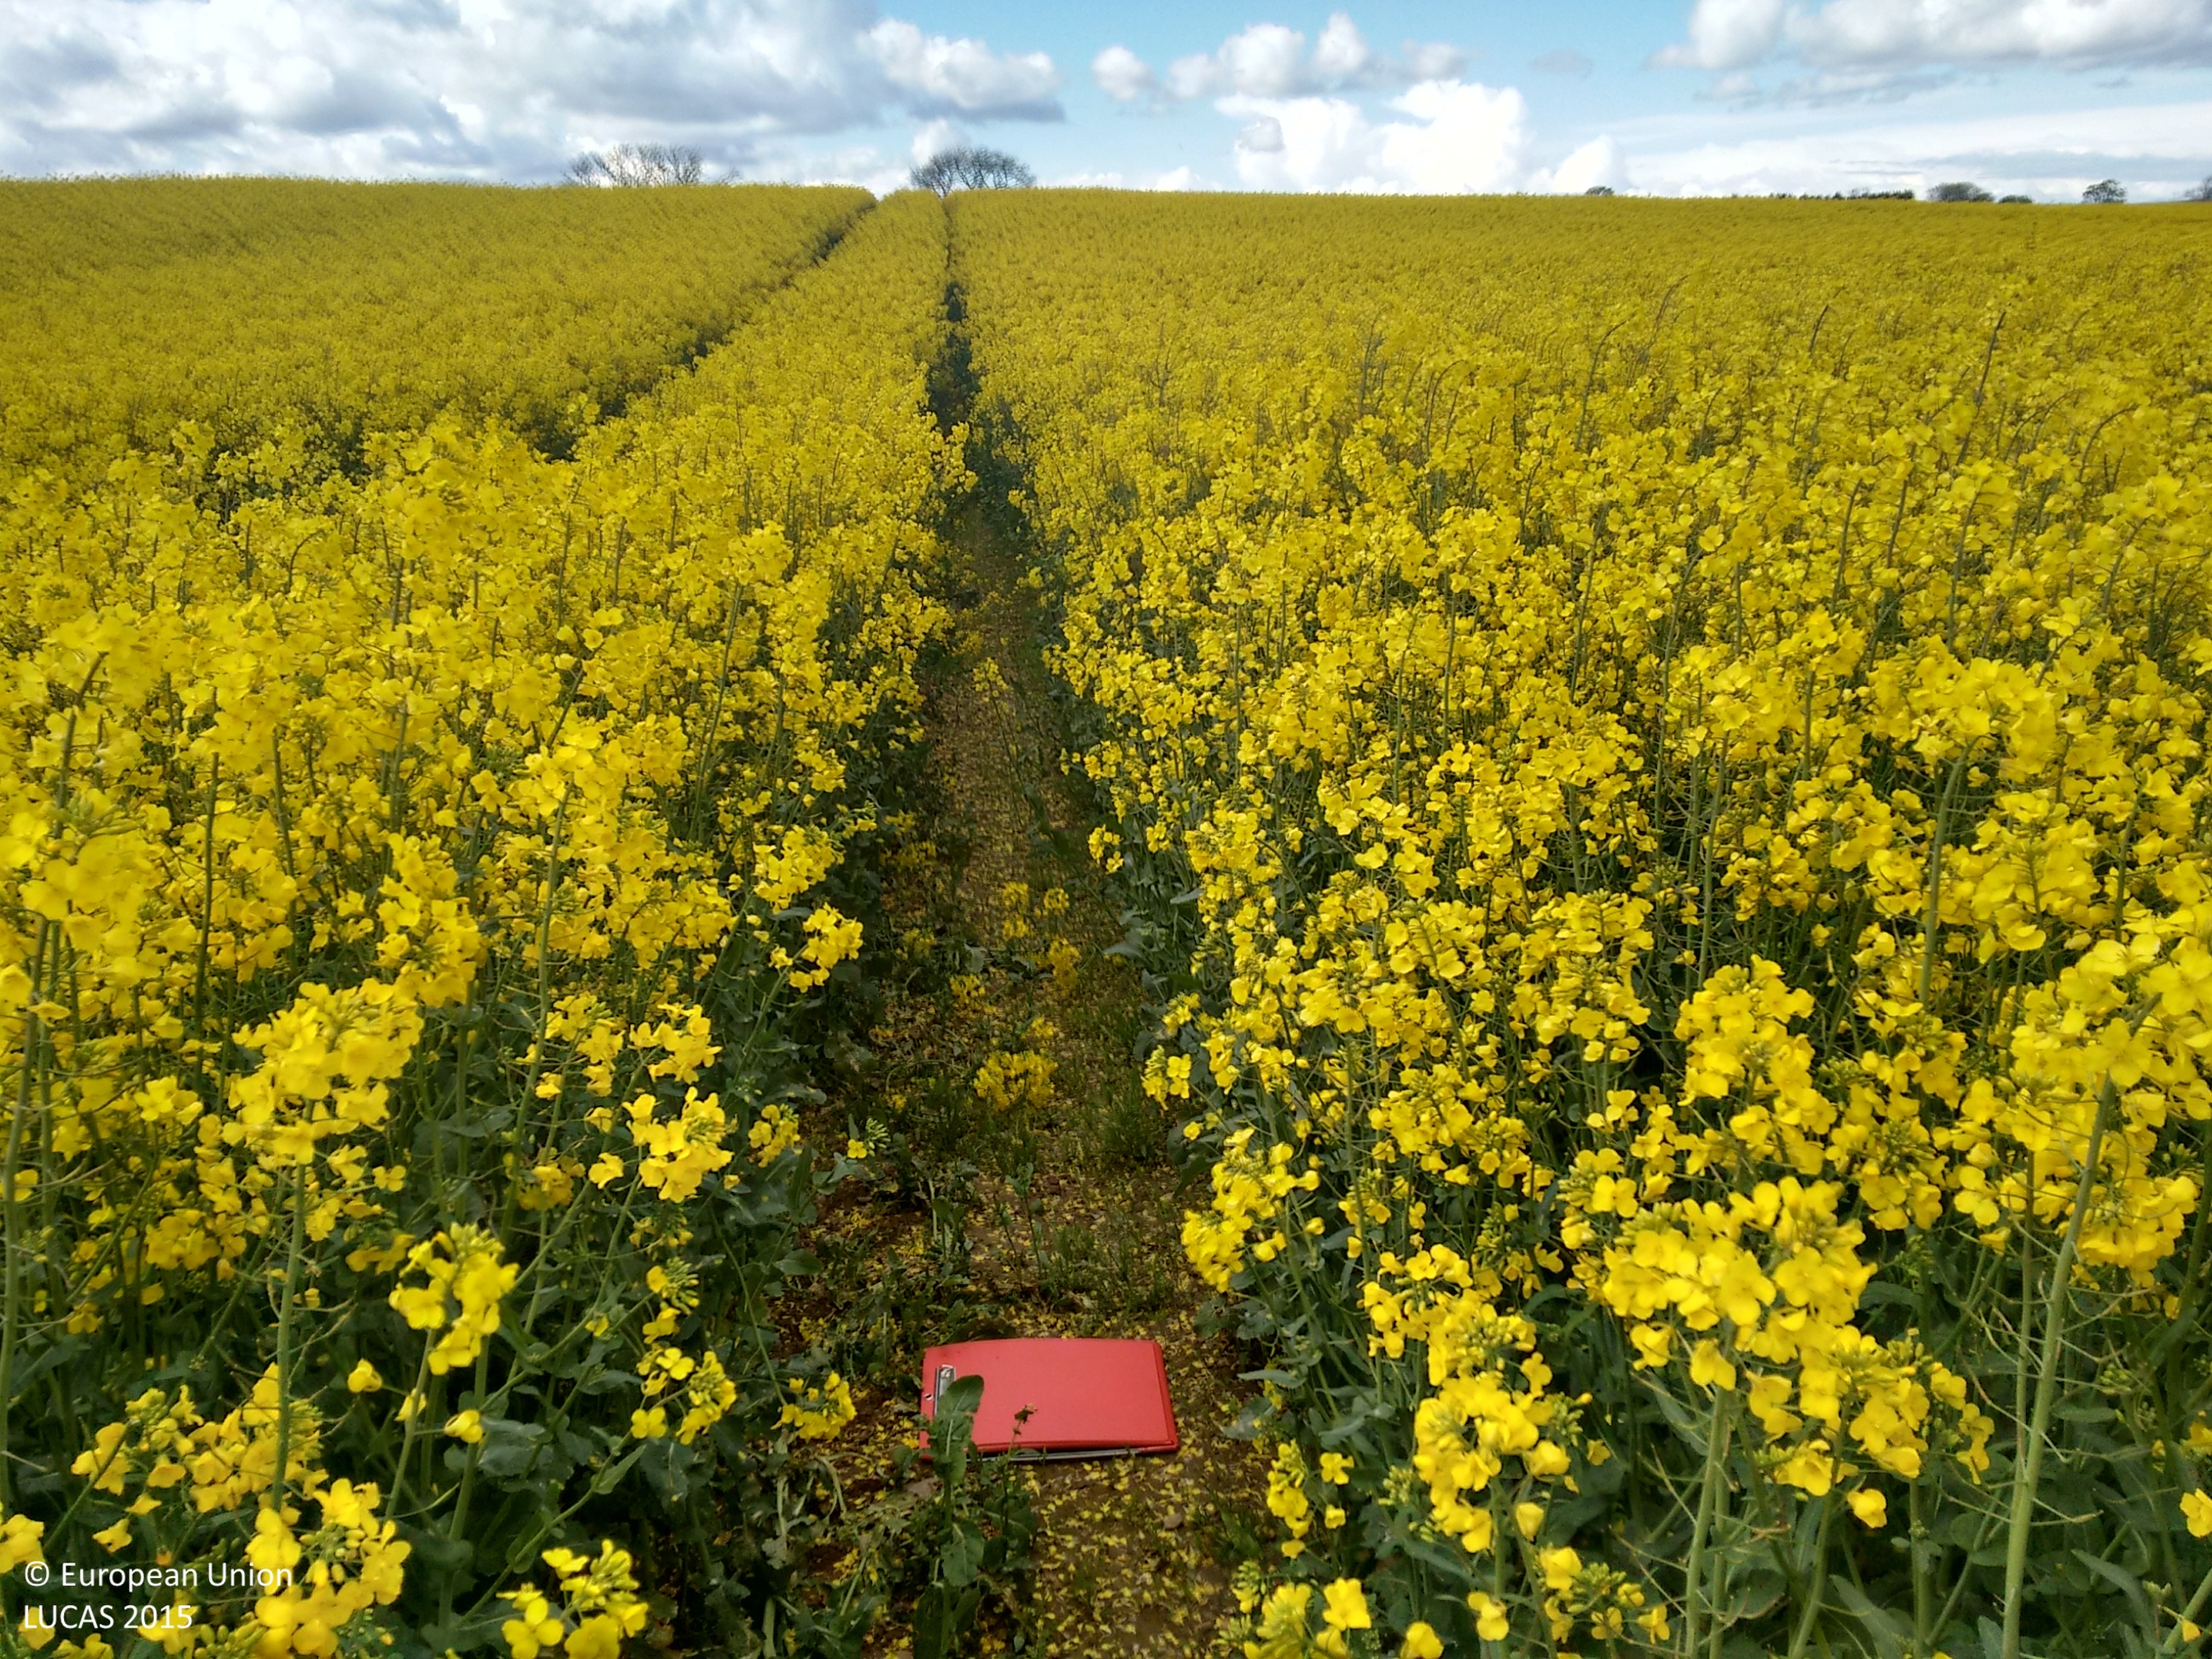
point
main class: Cropland
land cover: Rape and turnip rape
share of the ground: > 75 %
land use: Agriculture (excluding fallow land and kitchen gardens)
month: May
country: GB
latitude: 55.7530
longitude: -2.3420
